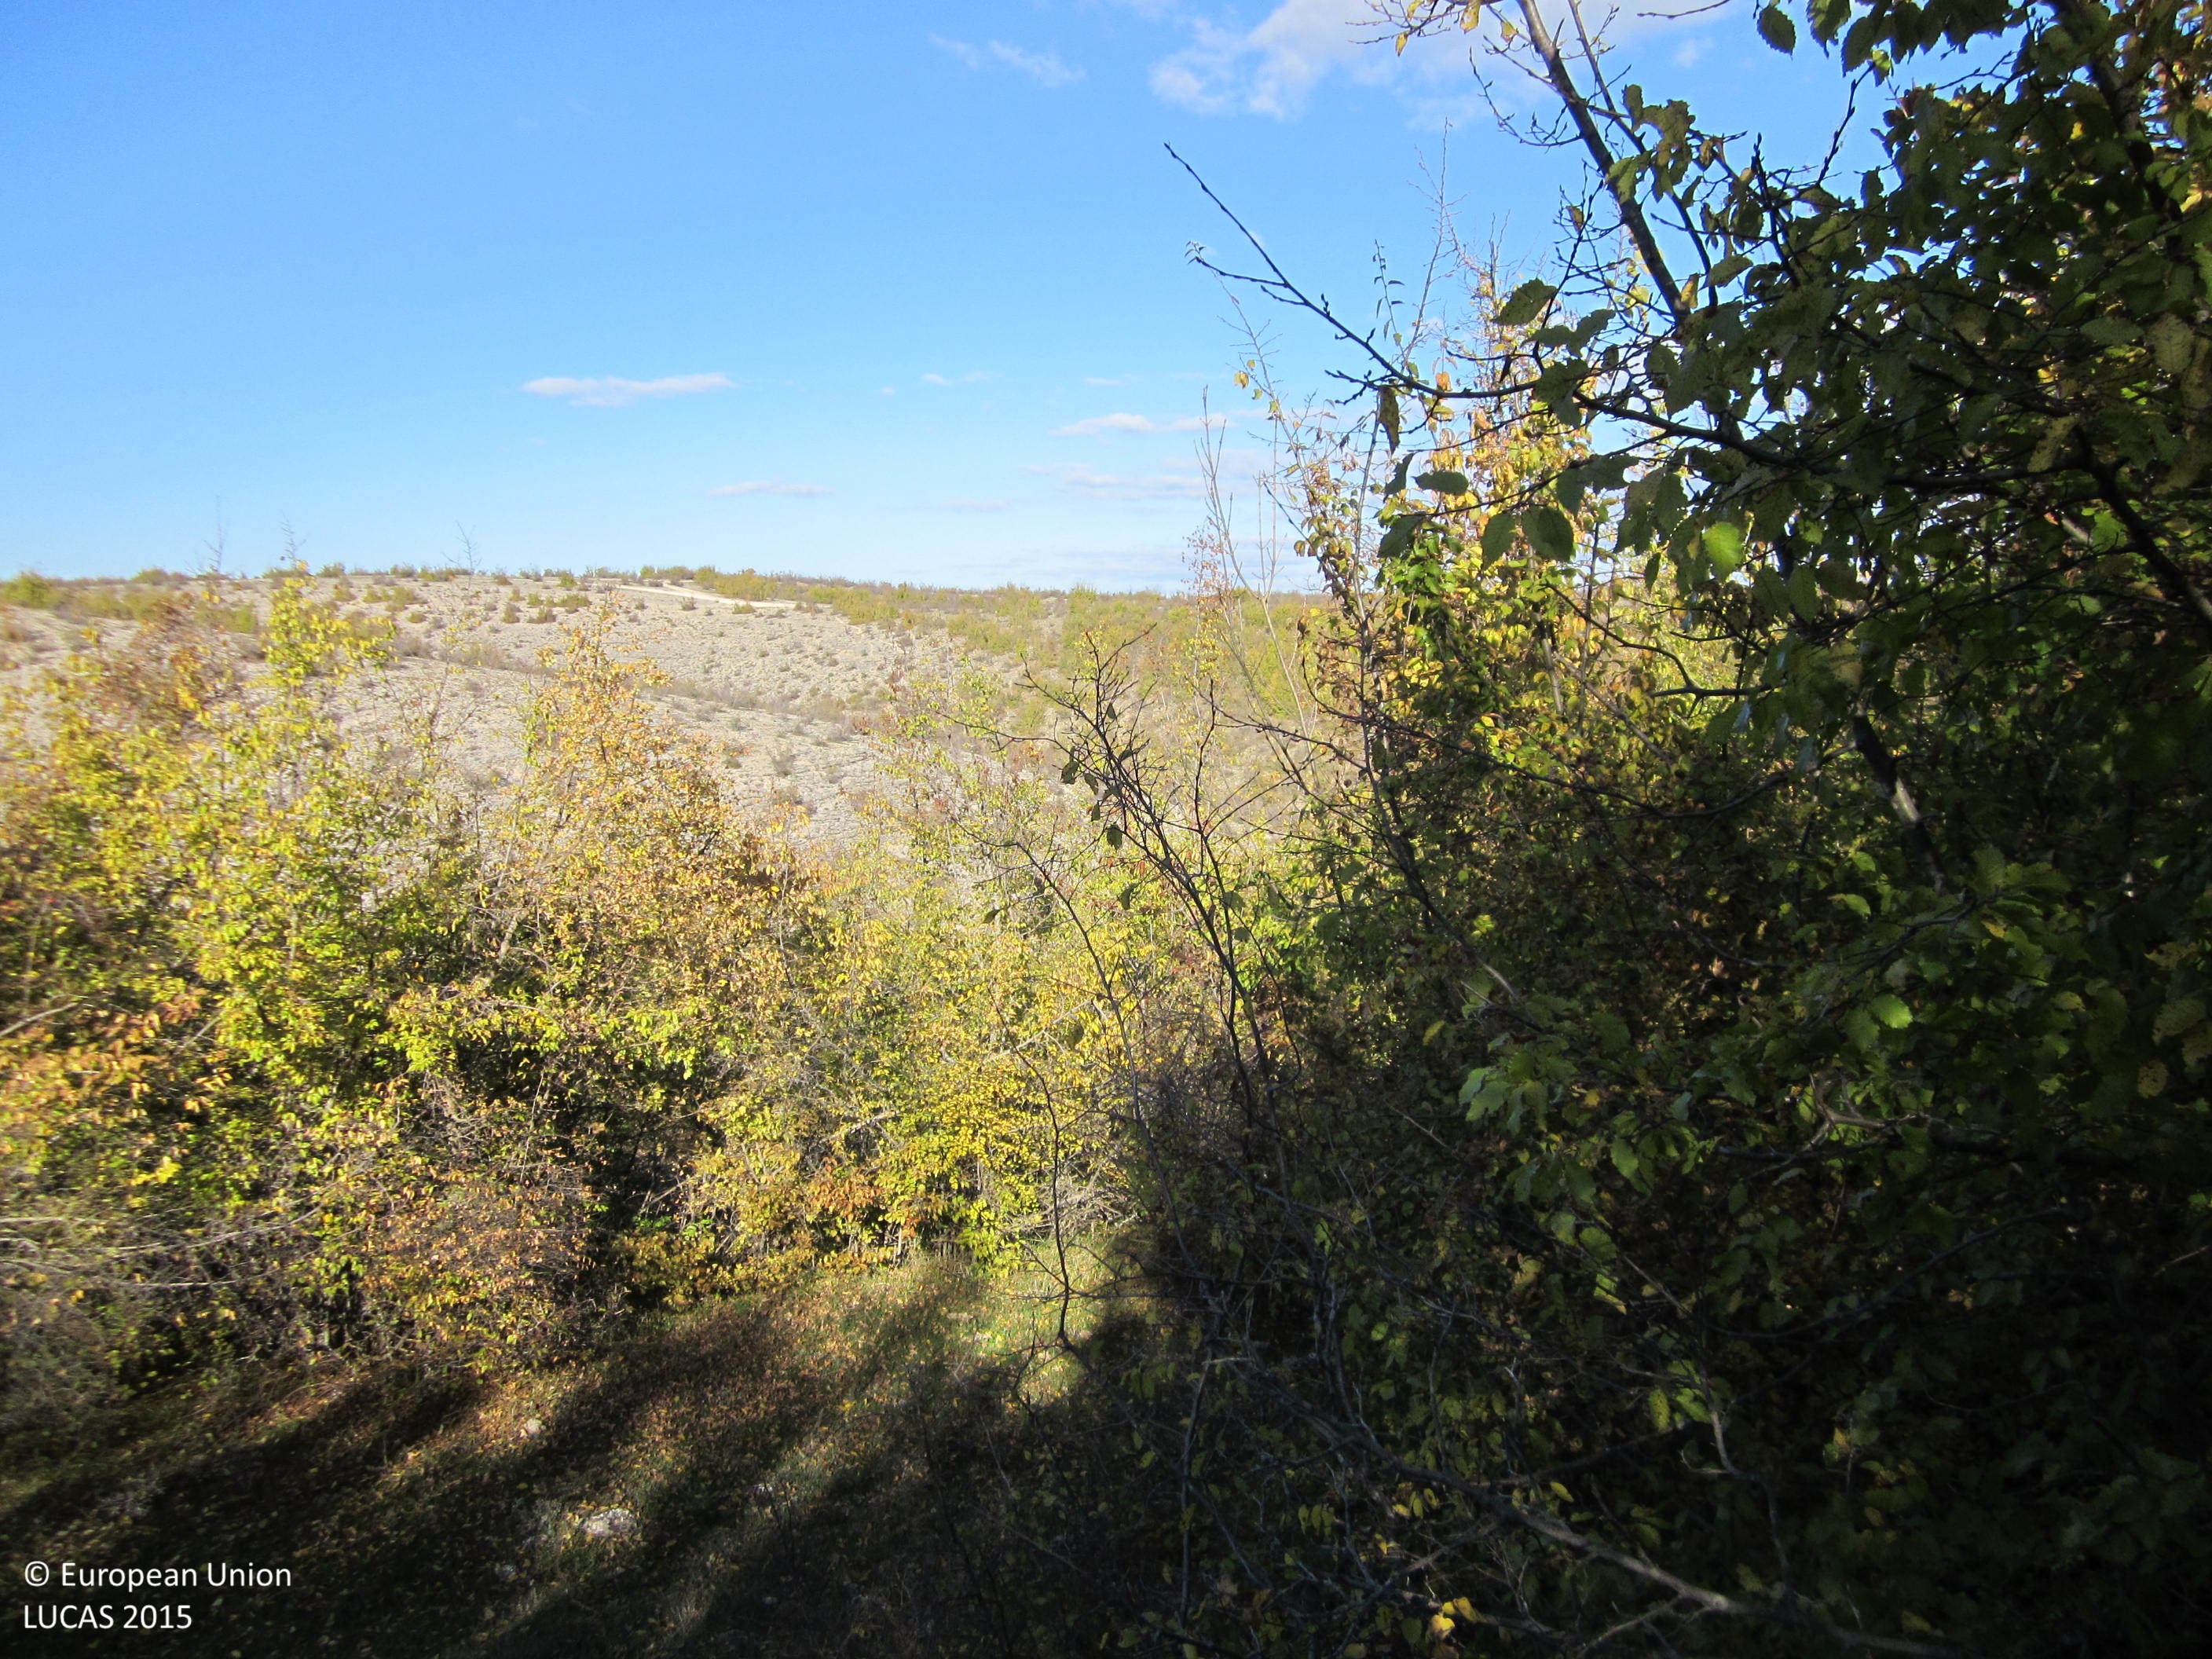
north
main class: Shrubland
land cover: Shrubland with sparse tree cover
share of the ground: > 75 %
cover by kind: shrubs 85 %, herbaceous plants 10 %, broadleaved forest trees 5 %
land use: Semi-natural and natural areas not in use
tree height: < 5 m
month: October
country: BG
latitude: 41.4257
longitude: 25.5533
